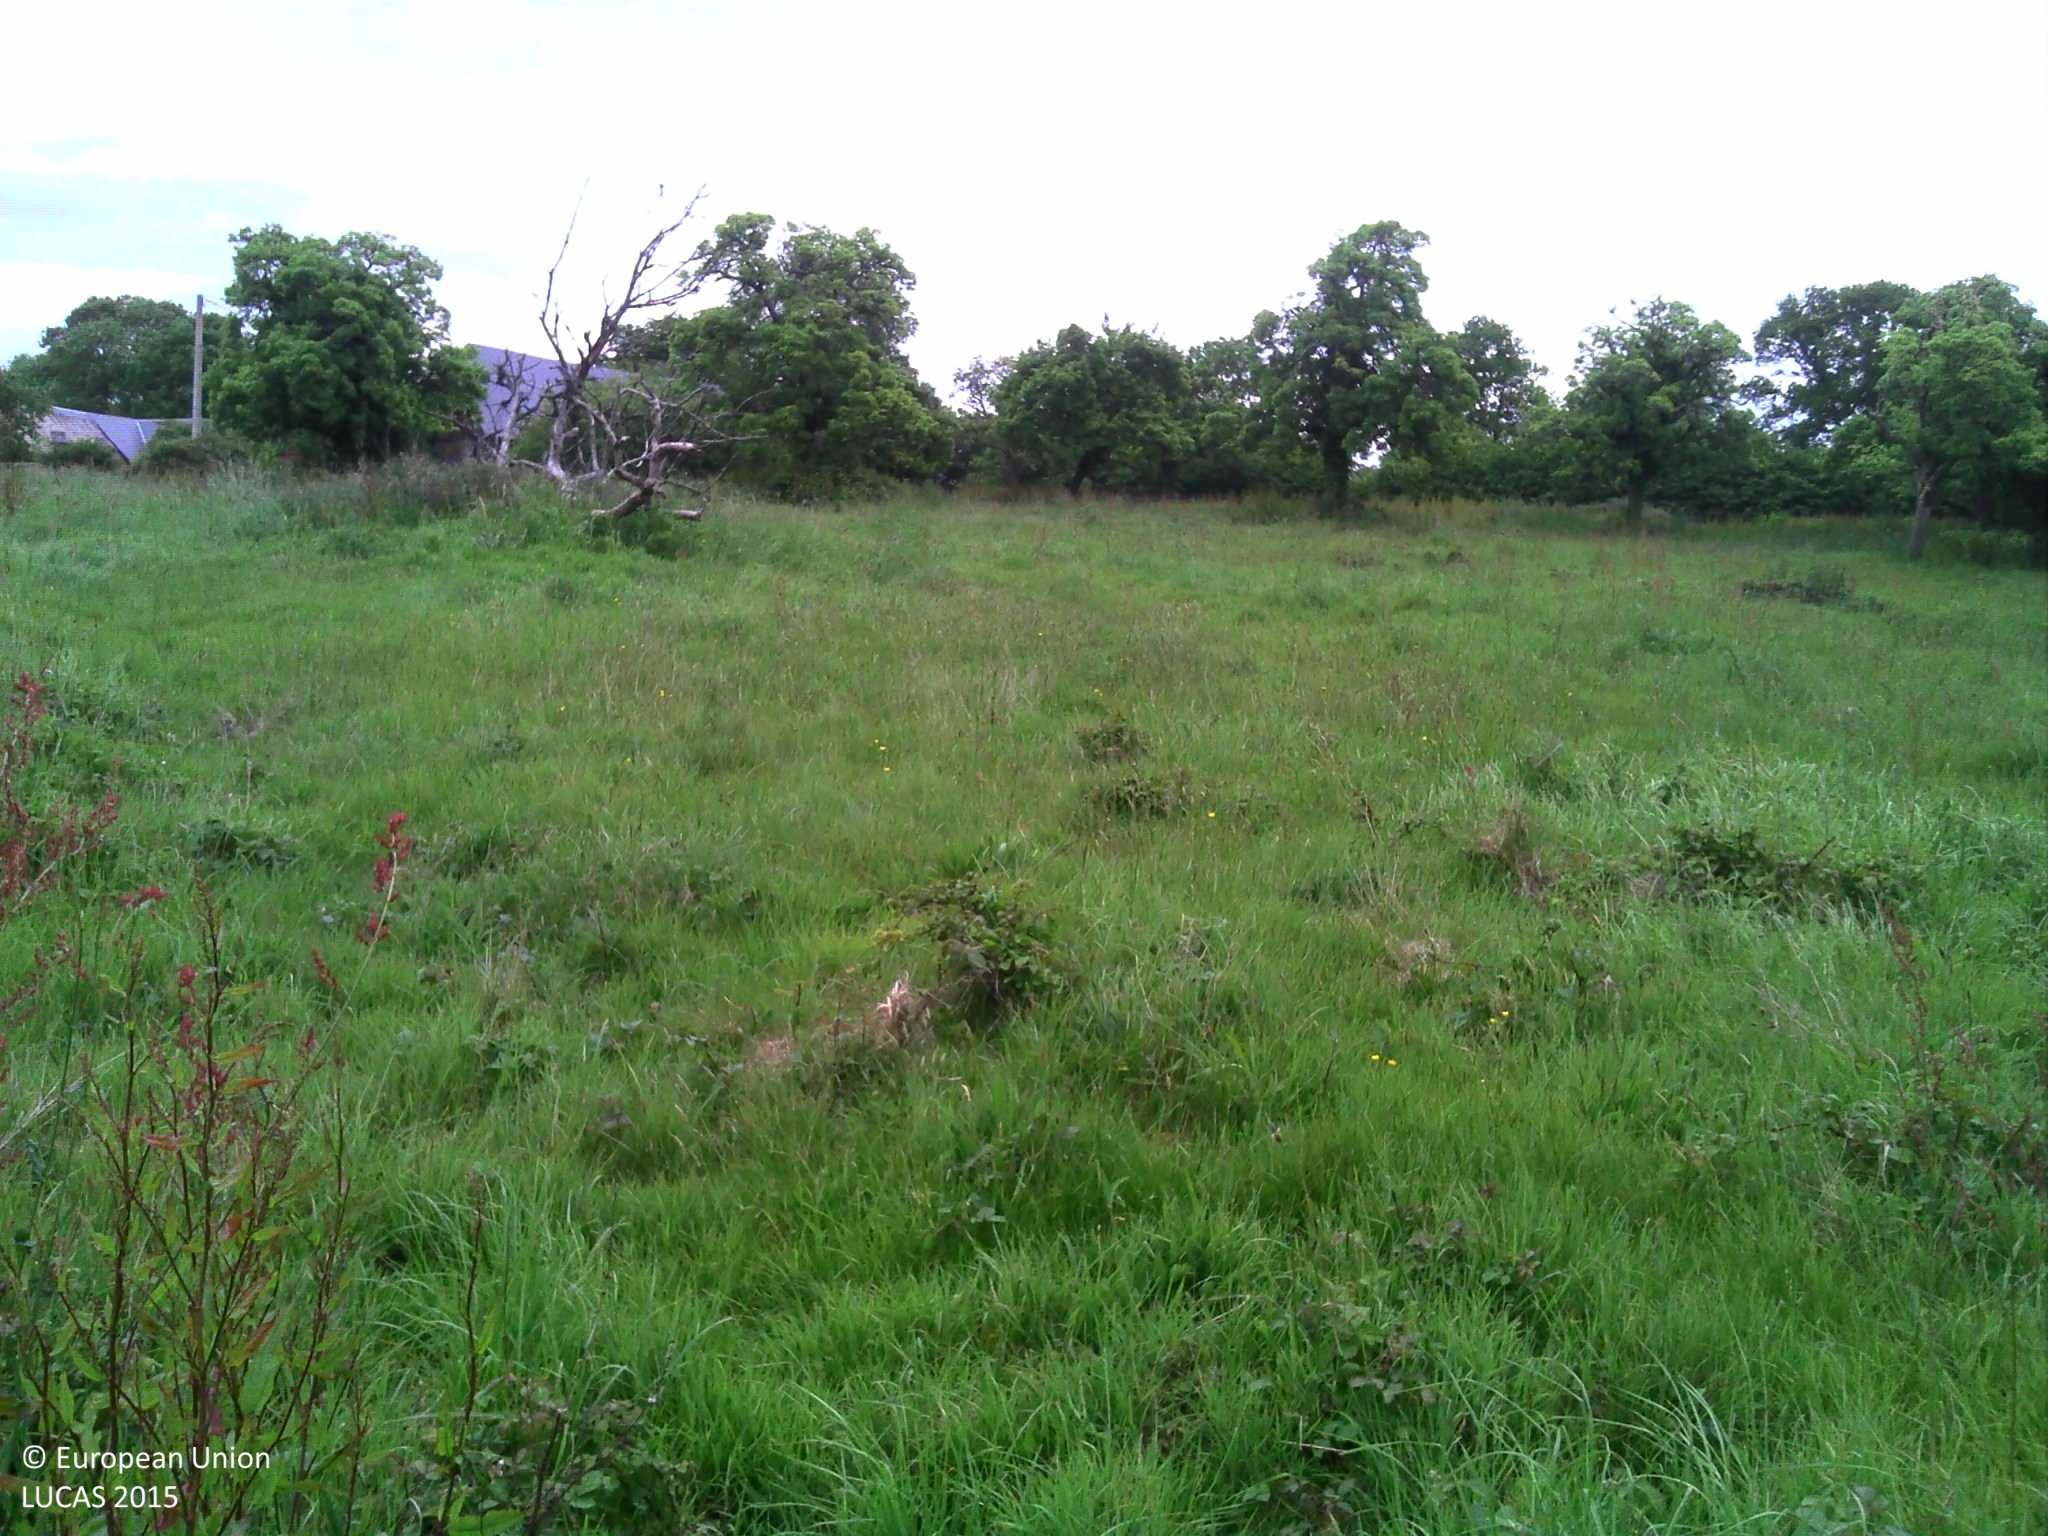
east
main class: Cropland
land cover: Pear fruit
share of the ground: < 10 %
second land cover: Grassland without tree/shrub cover
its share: > 75 %
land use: Agriculture (excluding fallow land and kitchen gardens)
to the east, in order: Pear fruit; Grassland without tree/shrub cover; Fences; Grassland with sparse tree/shrub cover; Artificial constructions in urban areas; Abandoned hedges; Grassland without tree/shrub cover; Abandoned hedges
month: May
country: FR
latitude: 49.2905
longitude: 0.0006
